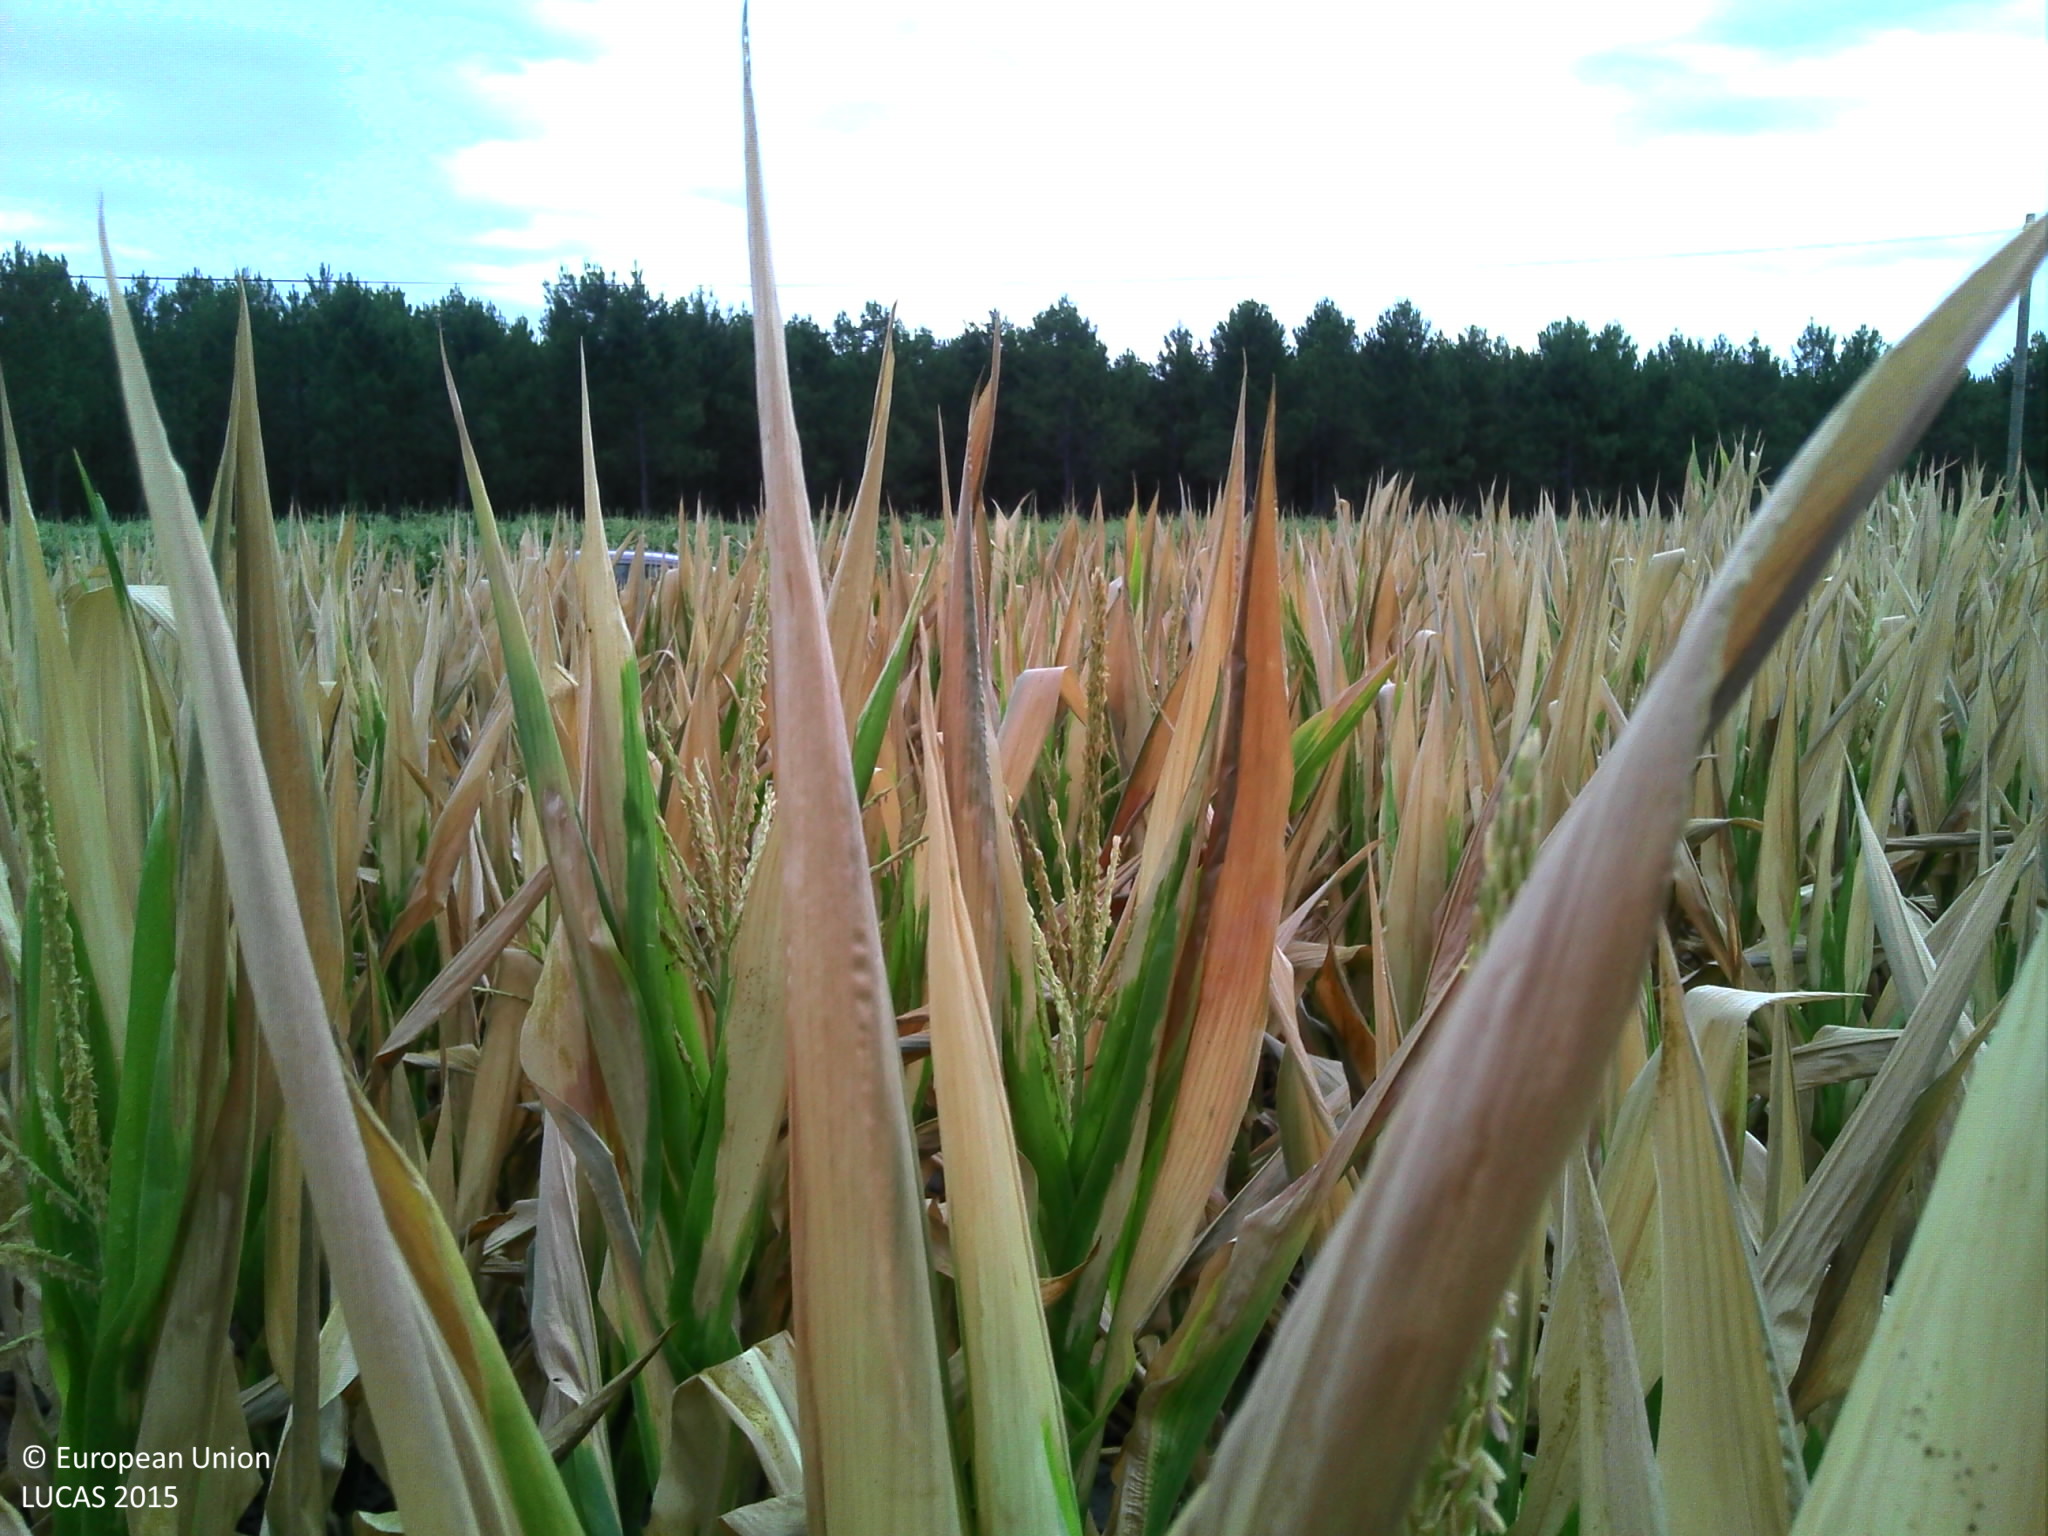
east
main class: Cropland
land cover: Maize
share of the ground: > 75 %
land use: Agriculture (excluding fallow land and kitchen gardens)
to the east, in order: Maize; Grassland with sparse tree/shrub cover; Ditches and canals; Grass margins; Electric lines; Grass margins; Paved roads, cycling and walking lanes; Grass margins; Maize; Tracks; Pine dominated coniferous woodland
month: July
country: FR
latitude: 44.3900
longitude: -0.9280
